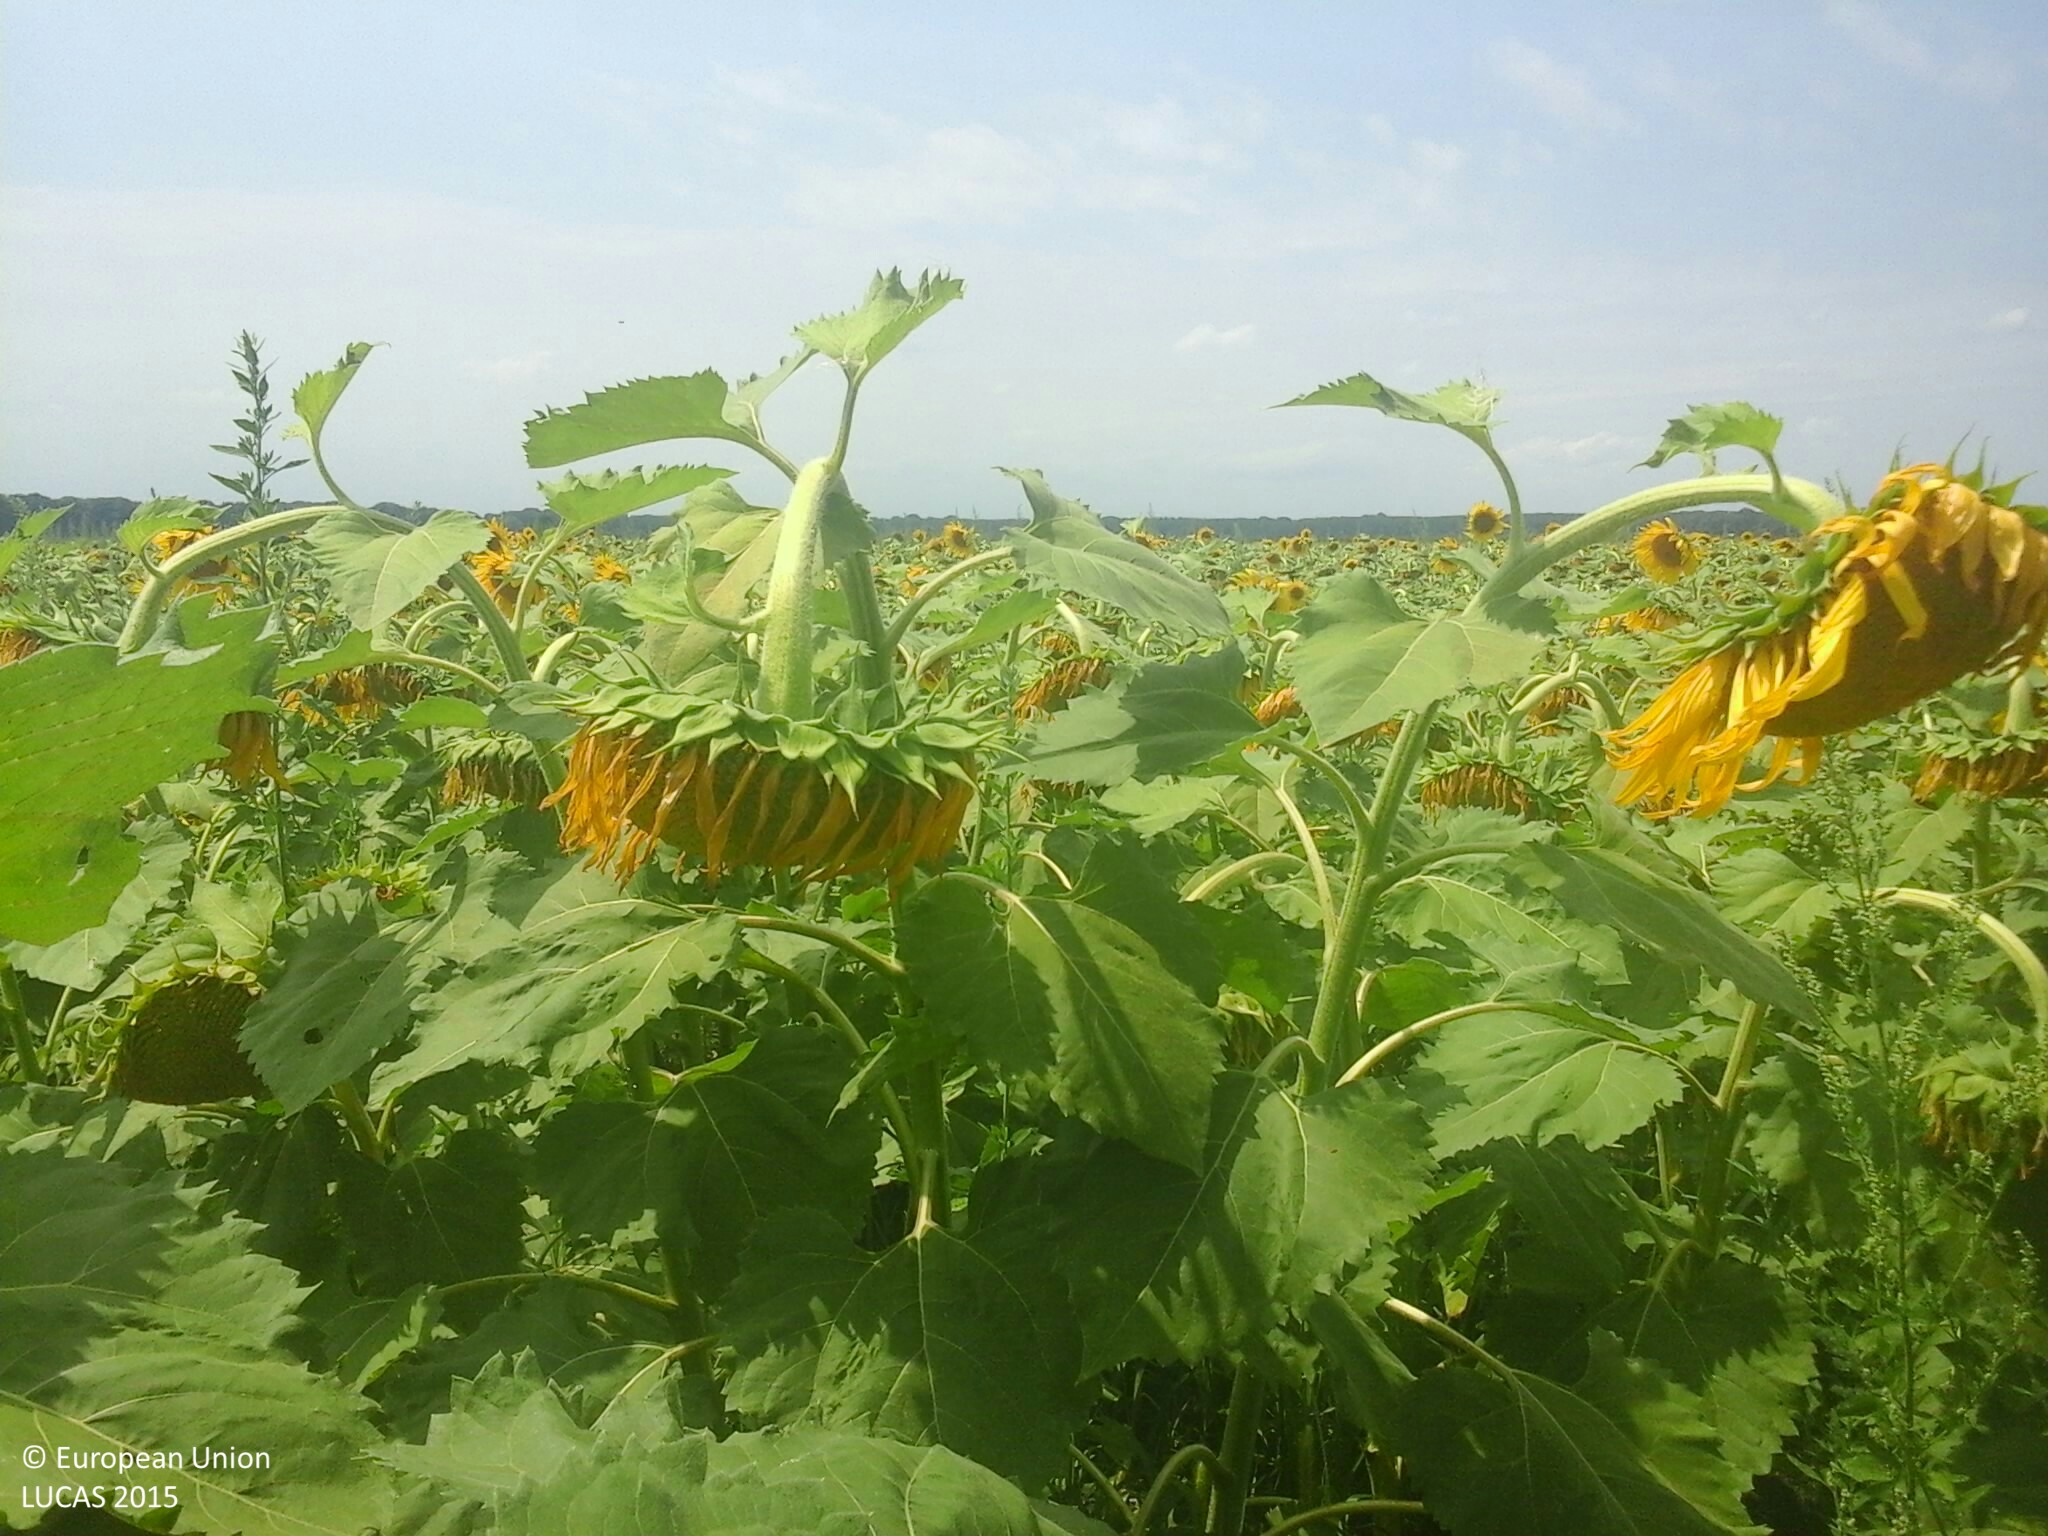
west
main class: Cropland
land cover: Sunflower
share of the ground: > 75 %
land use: Agriculture (excluding fallow land and kitchen gardens)
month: July
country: HU
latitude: 46.7974
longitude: 20.0992
